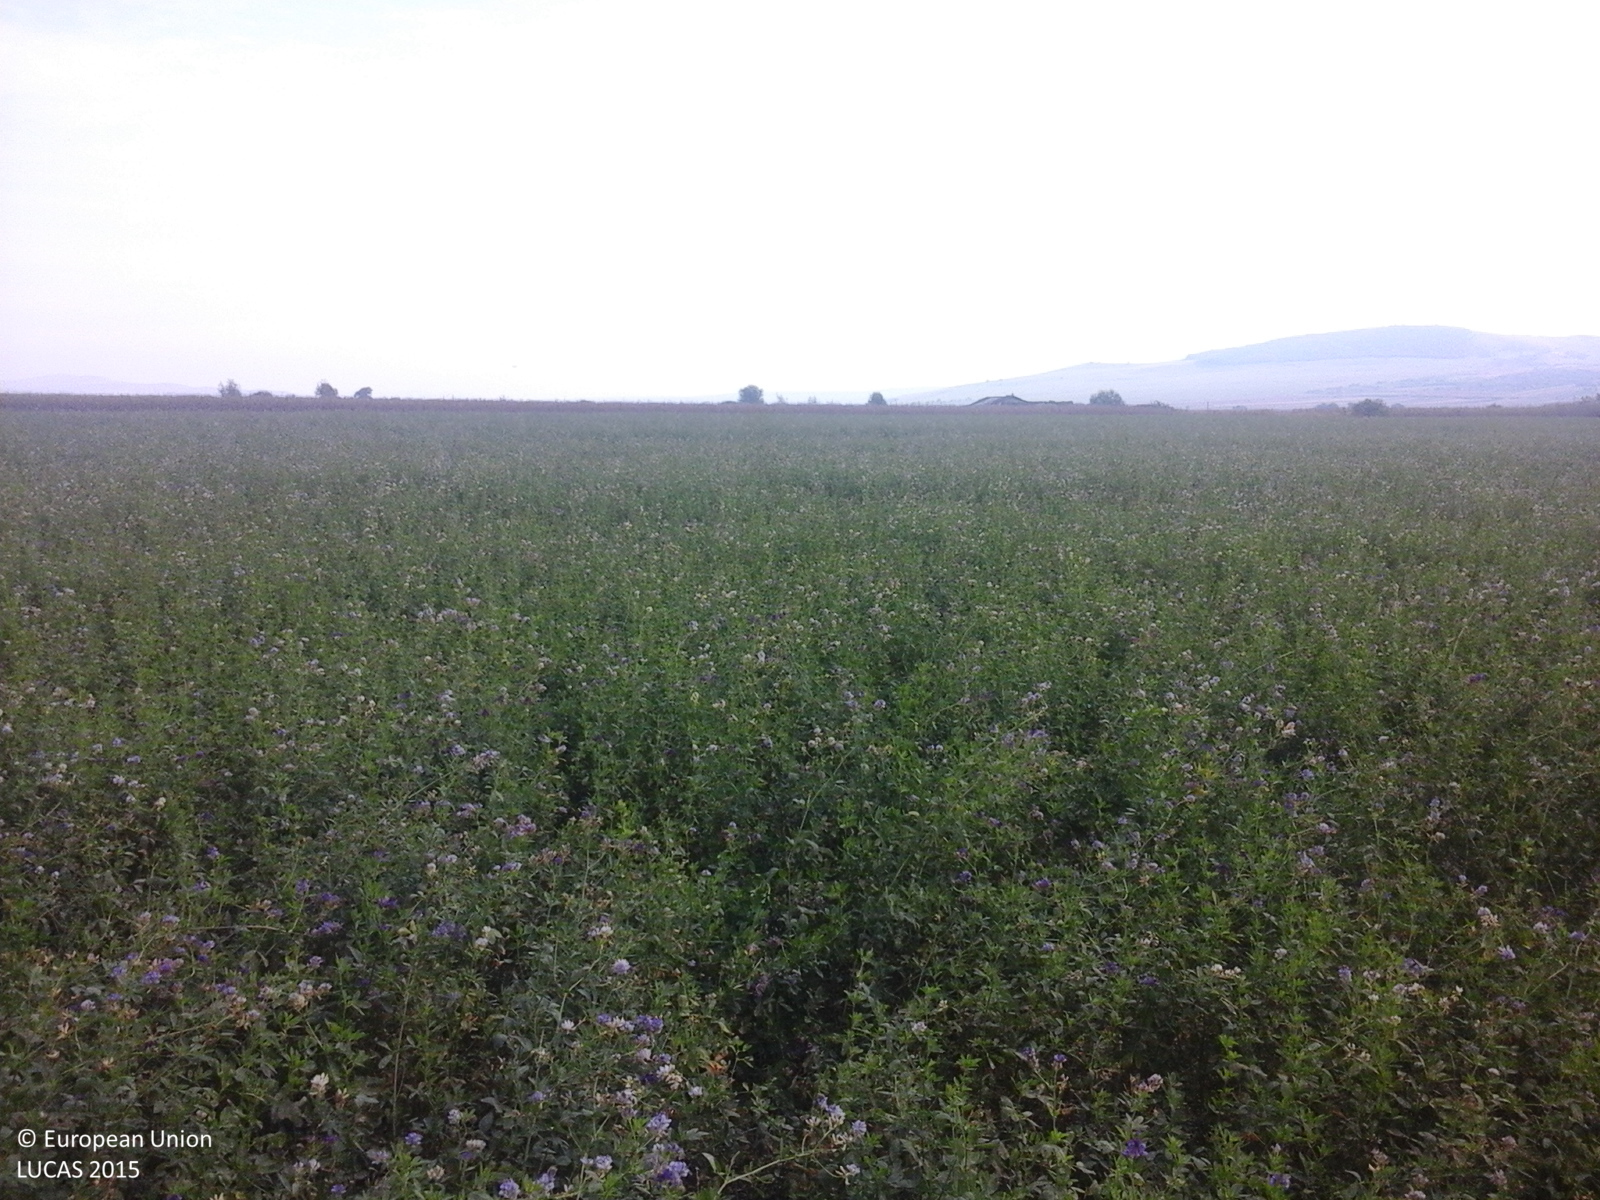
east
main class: Cropland
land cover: Lucerne
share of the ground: > 75 %
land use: Agriculture (excluding fallow land and kitchen gardens)
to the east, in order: Tracks; Lucerne; Maize
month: October
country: RO
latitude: 46.1567
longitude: 23.5726
